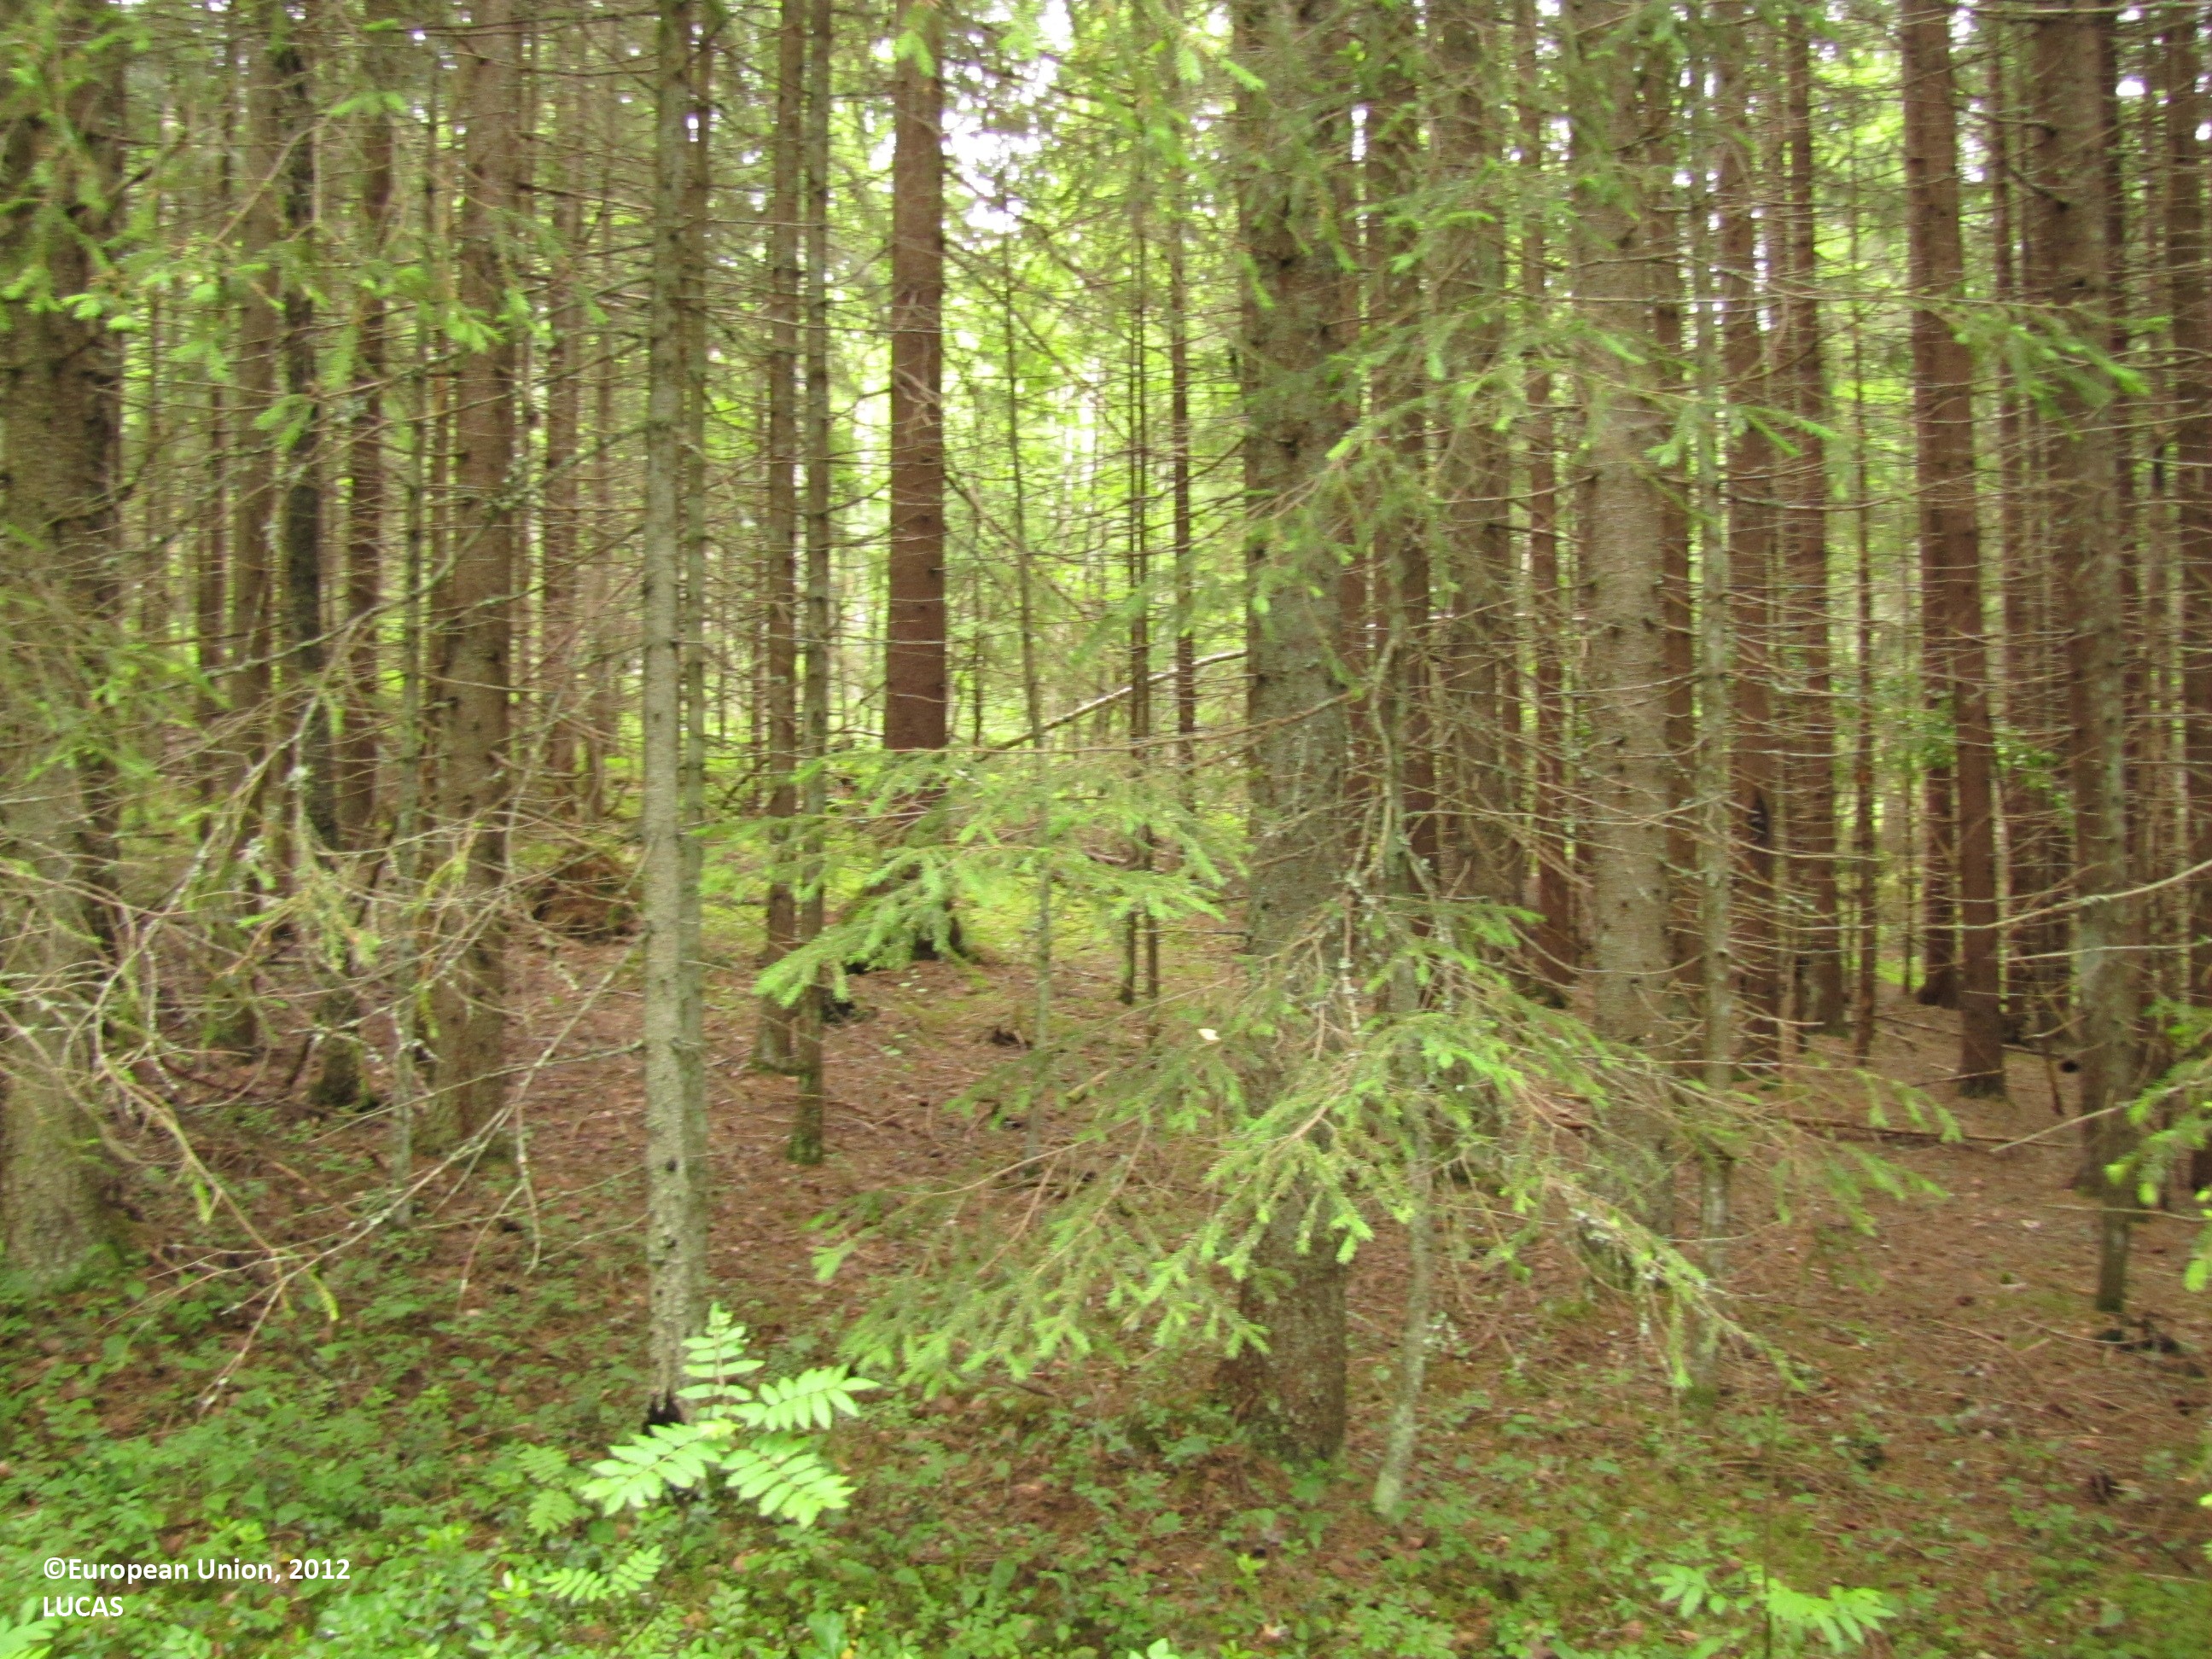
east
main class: Woodland
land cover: Spruce dominated coniferous woodland
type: boreal forest
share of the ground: > 75 %
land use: Forestry
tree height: > 5 m
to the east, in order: Spruce dominated coniferous woodland; Spruce dominated mixed woodland; Spruce dominated coniferous woodland
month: June
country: FI
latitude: 61.7707
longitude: 24.5575
